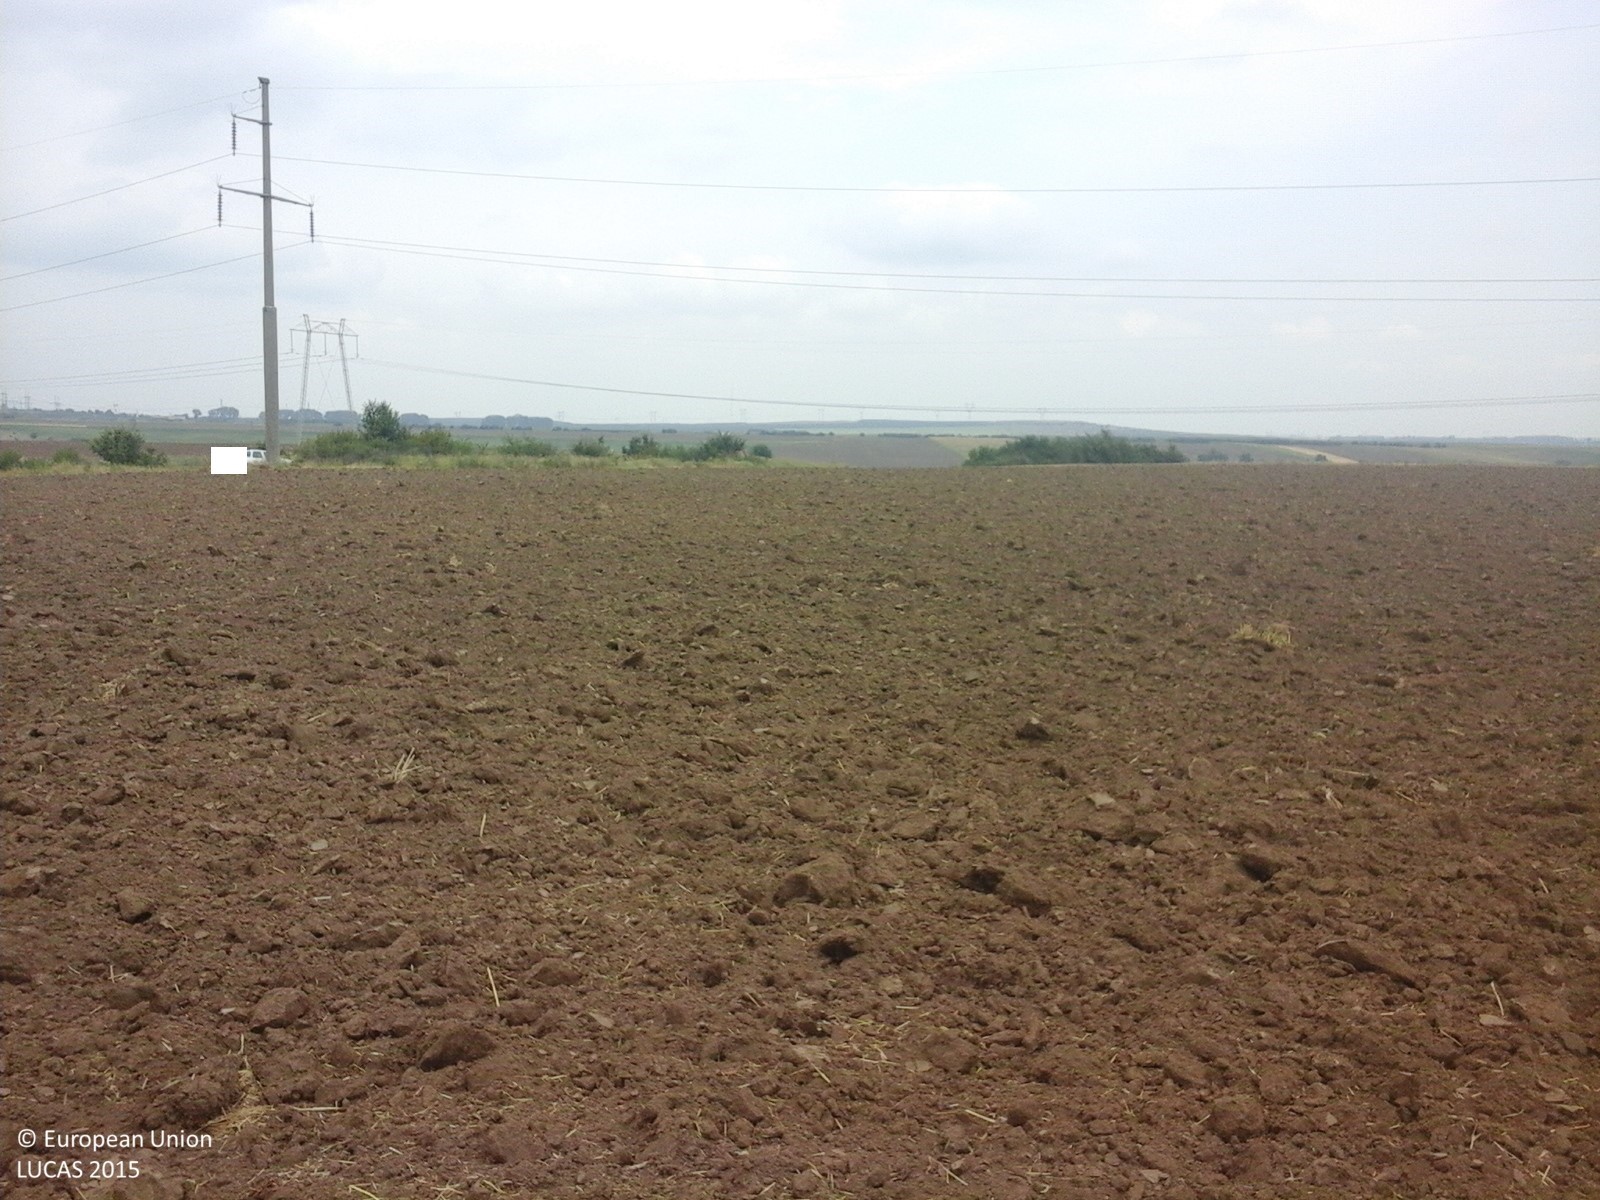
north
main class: Cropland
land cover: Common wheat
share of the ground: < 10 %
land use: Agriculture (excluding fallow land and kitchen gardens)
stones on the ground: < 10 %
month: July
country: RO
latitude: 45.2208
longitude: 28.4815
